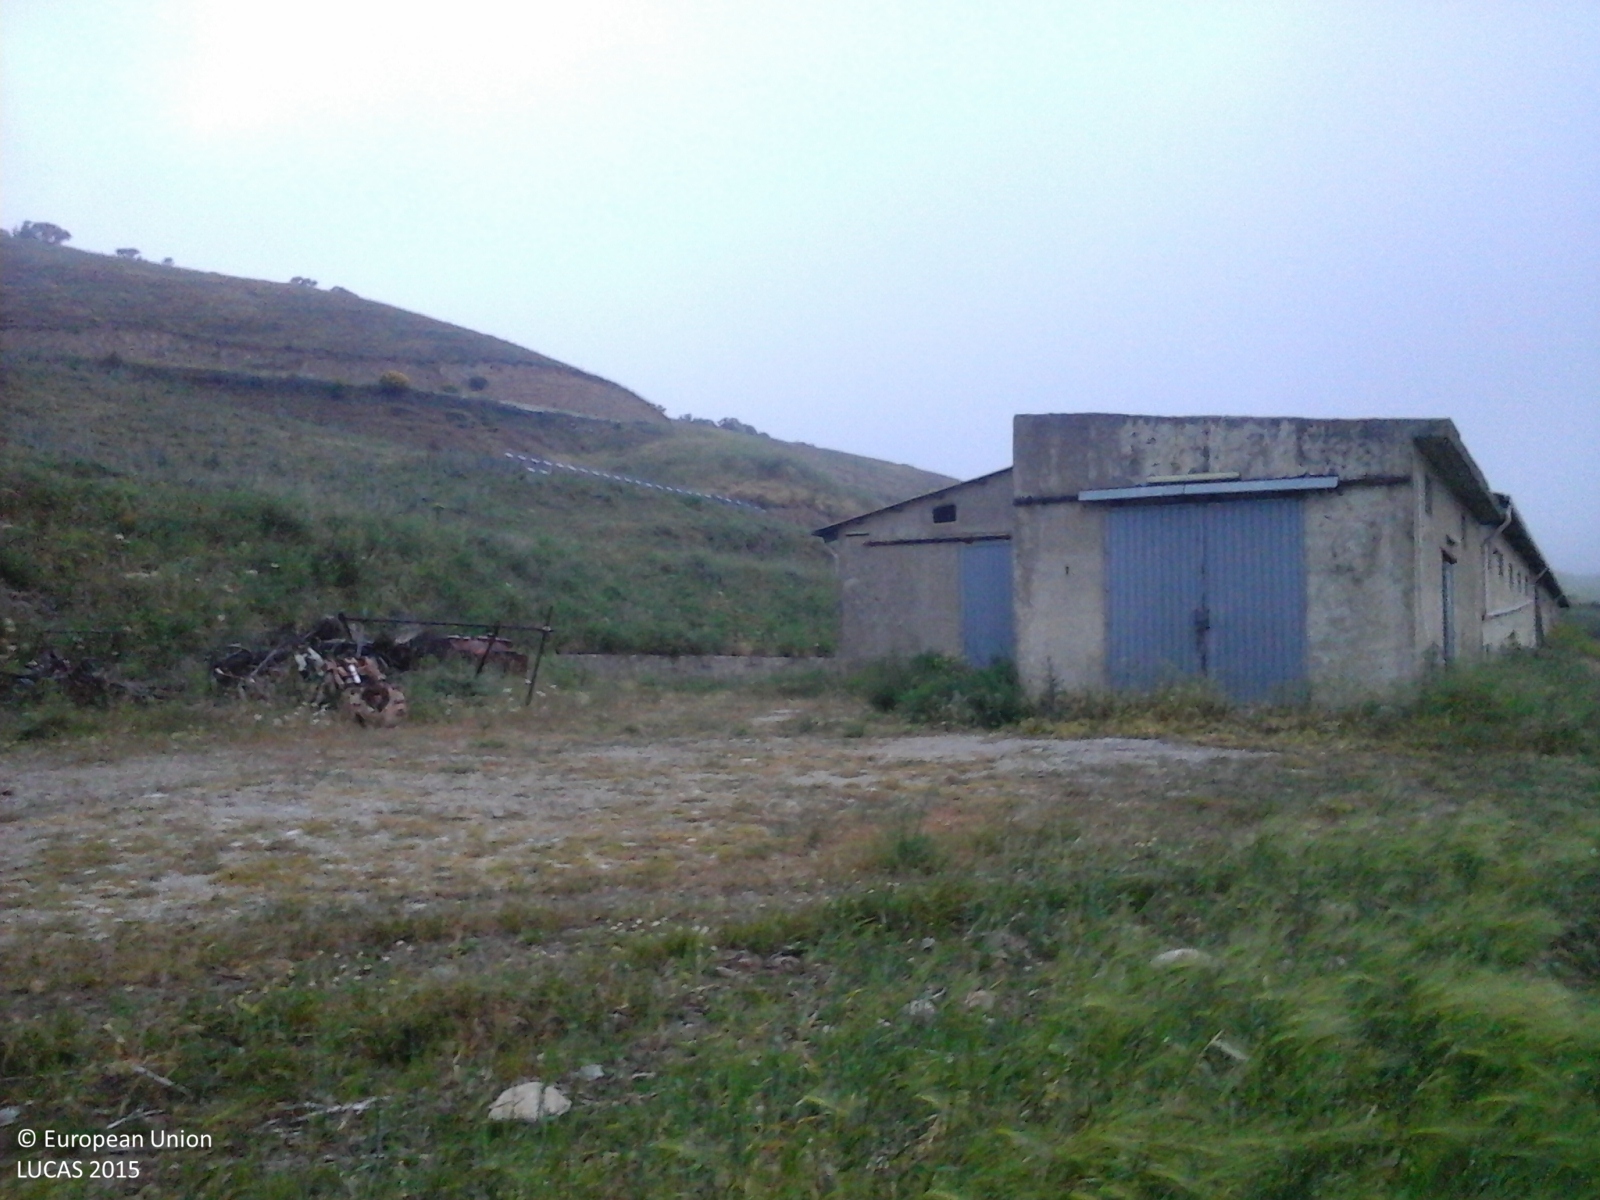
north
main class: Cropland
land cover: Barley
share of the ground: > 75 %
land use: Agriculture (excluding fallow land and kitchen gardens)
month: May
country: IT
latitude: 37.7542
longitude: 14.0004
